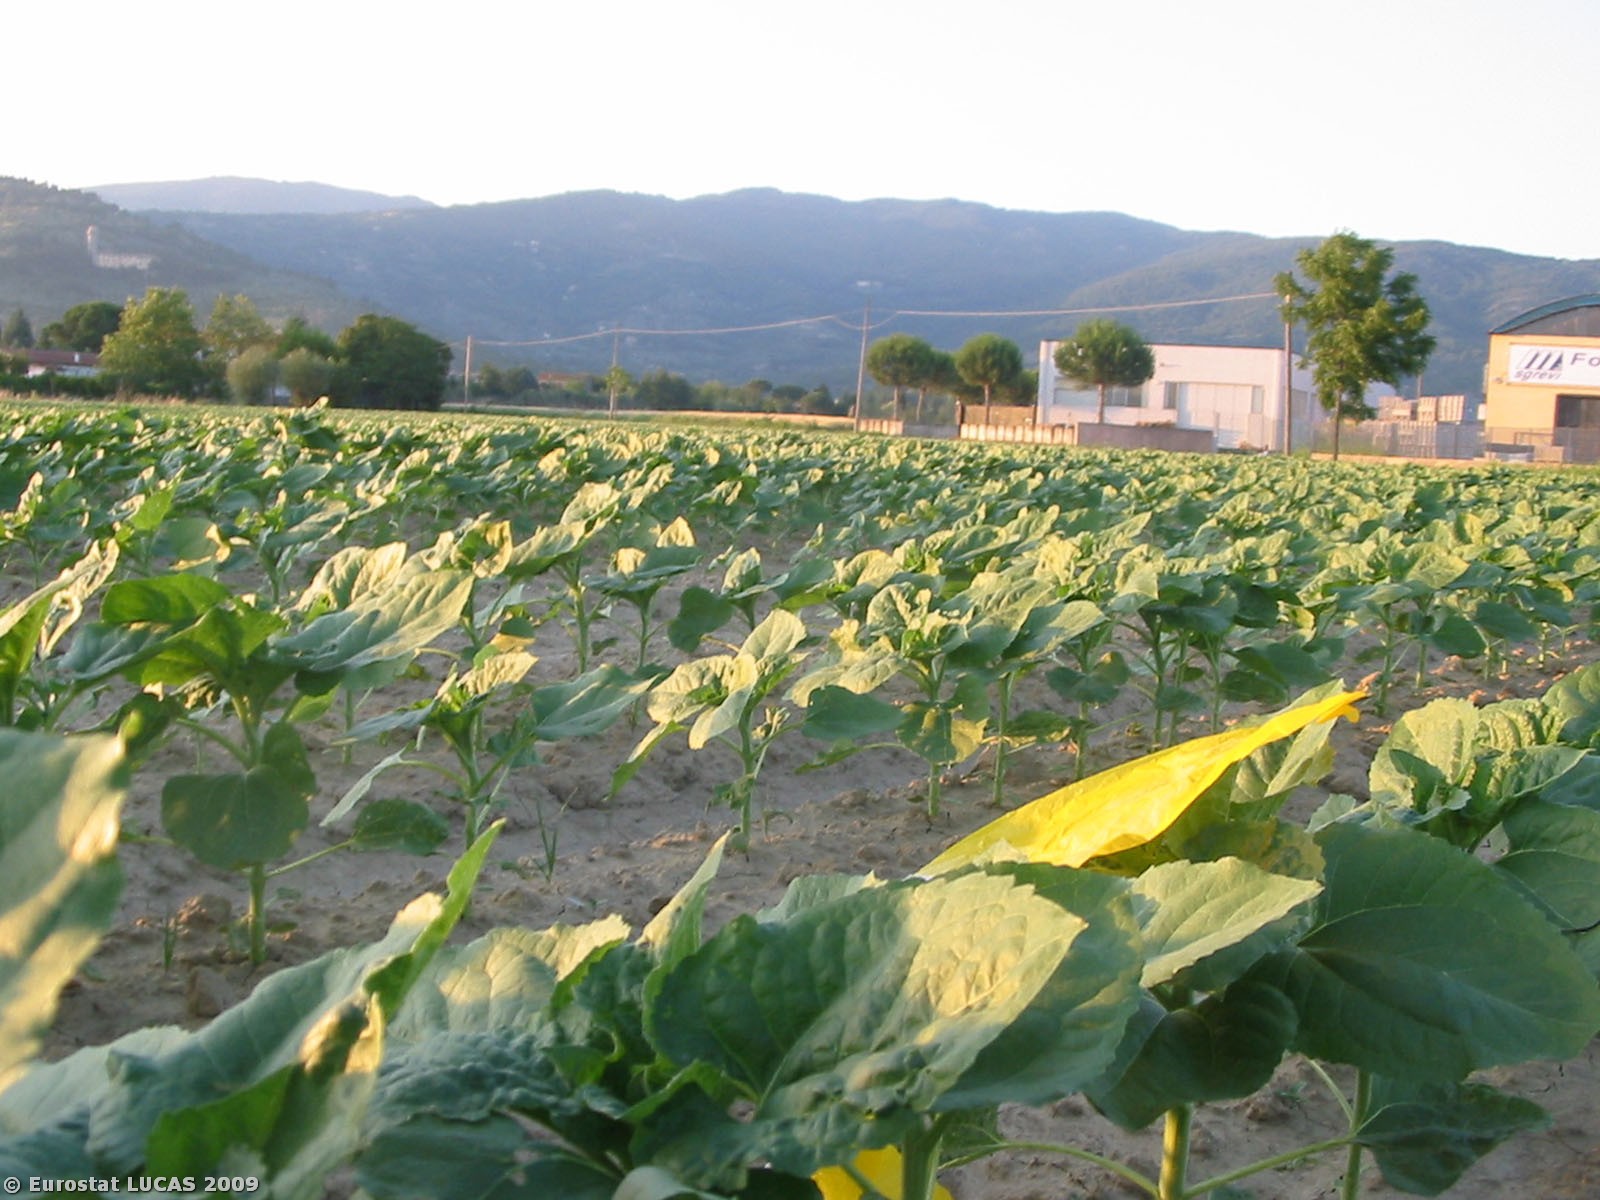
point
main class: Cropland
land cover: Sunflower
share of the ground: > 75 %
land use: Agriculture (excluding fallow land and kitchen gardens)
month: June
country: IT
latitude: 43.2483
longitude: 12.0018
